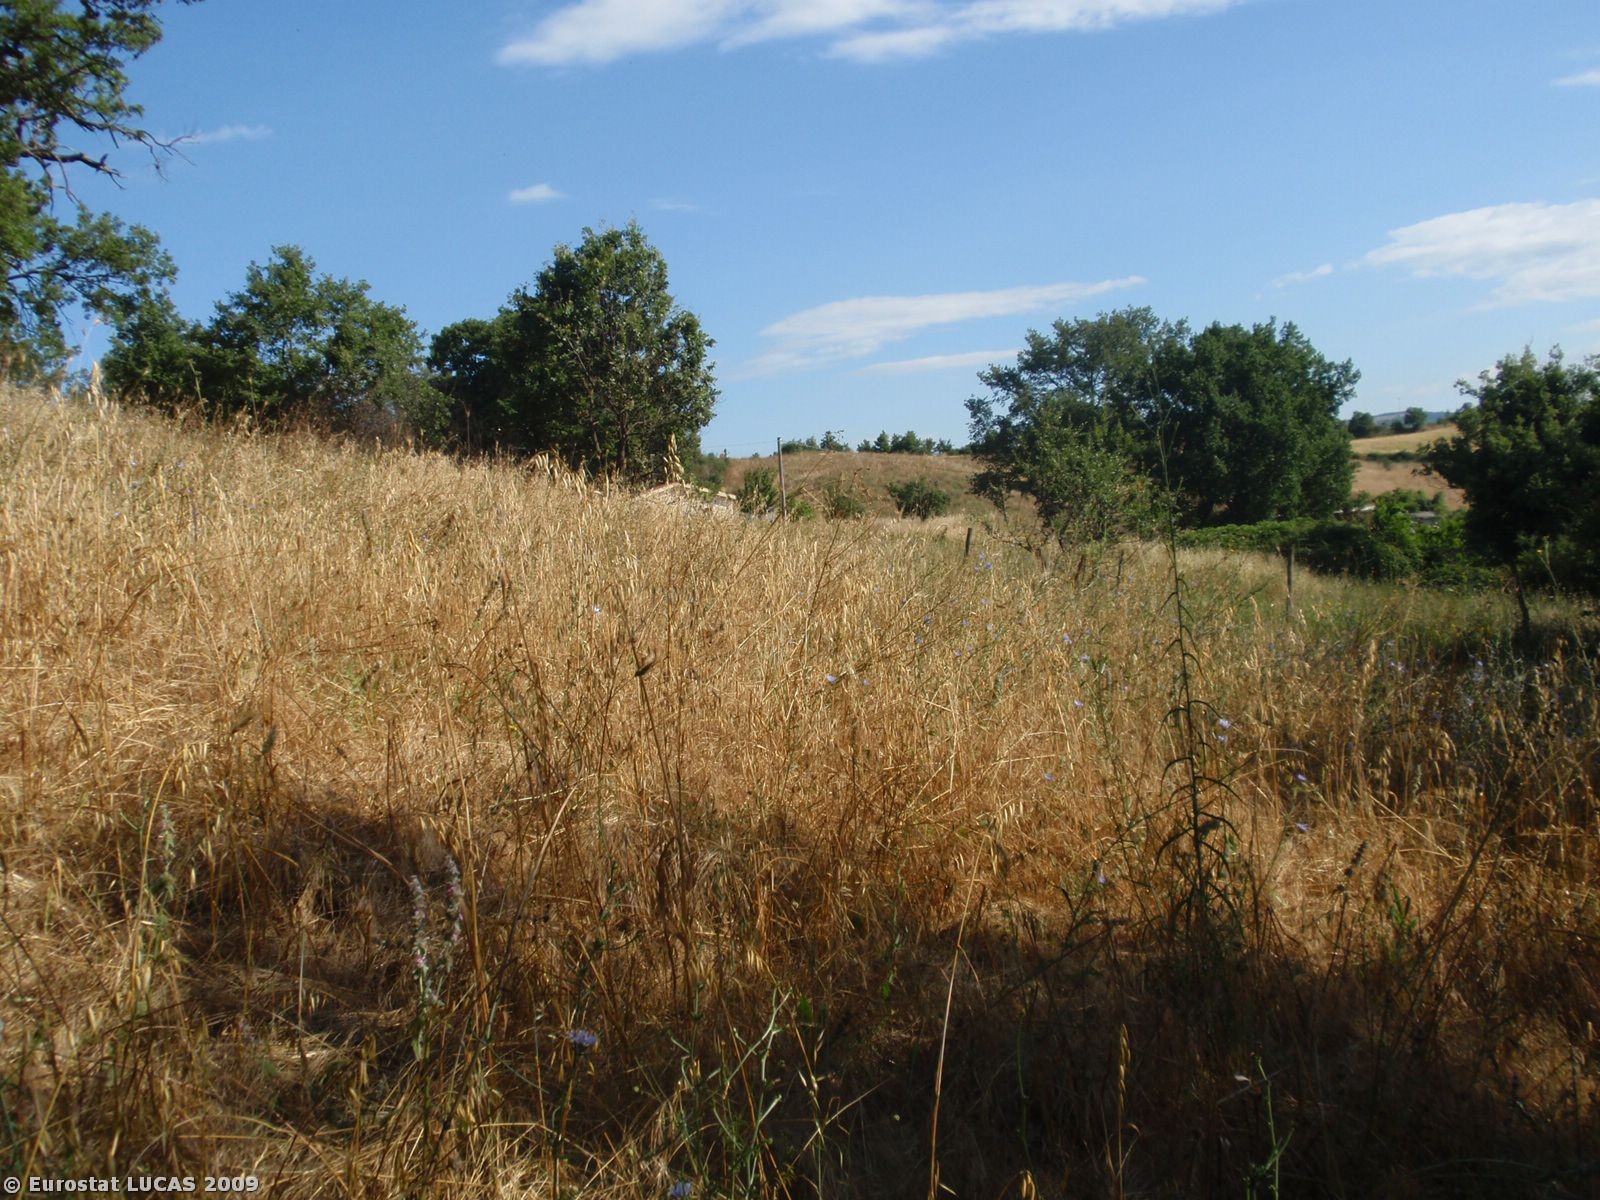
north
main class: Woodland
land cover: Broadleaved woodland
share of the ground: > 75 %
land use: Unused
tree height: > 5 m
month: June
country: IT
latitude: 40.3310
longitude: 16.1079
